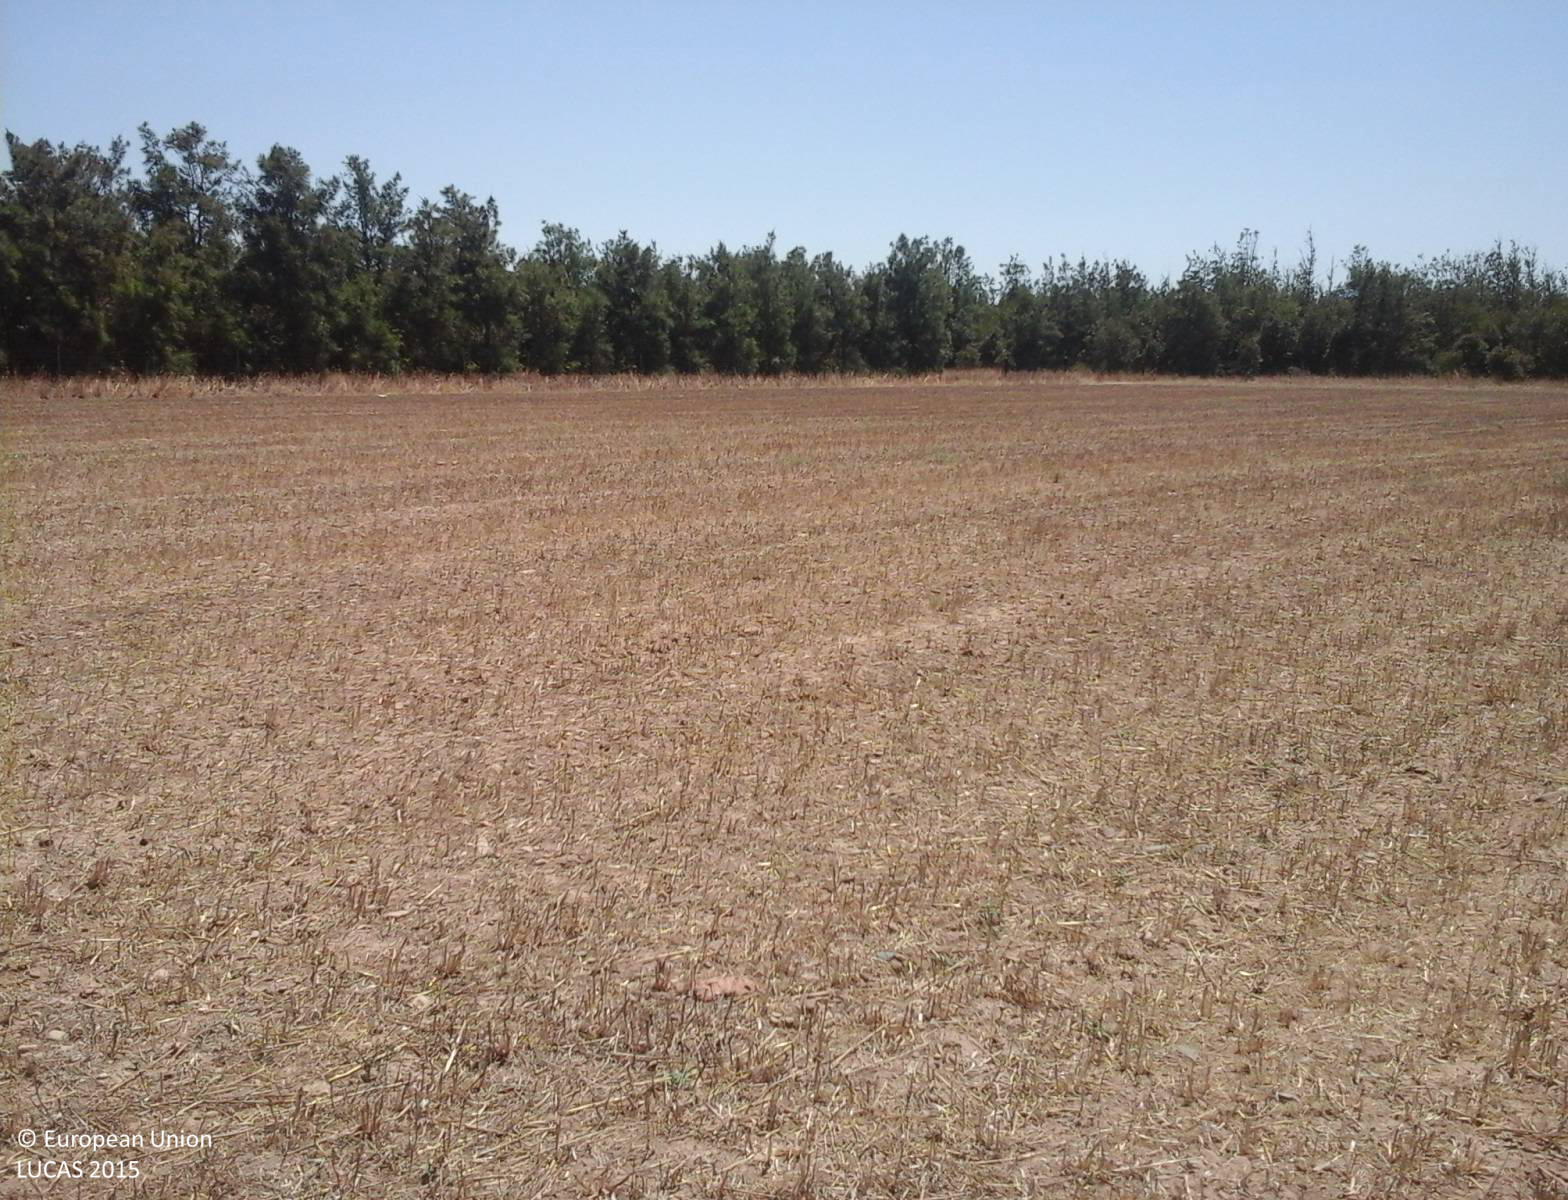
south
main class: Cropland
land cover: Mixed cereals for fodder
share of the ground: > 75 %
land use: Agriculture (excluding fallow land and kitchen gardens)
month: August
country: IT
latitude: 39.3737
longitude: 8.9039
